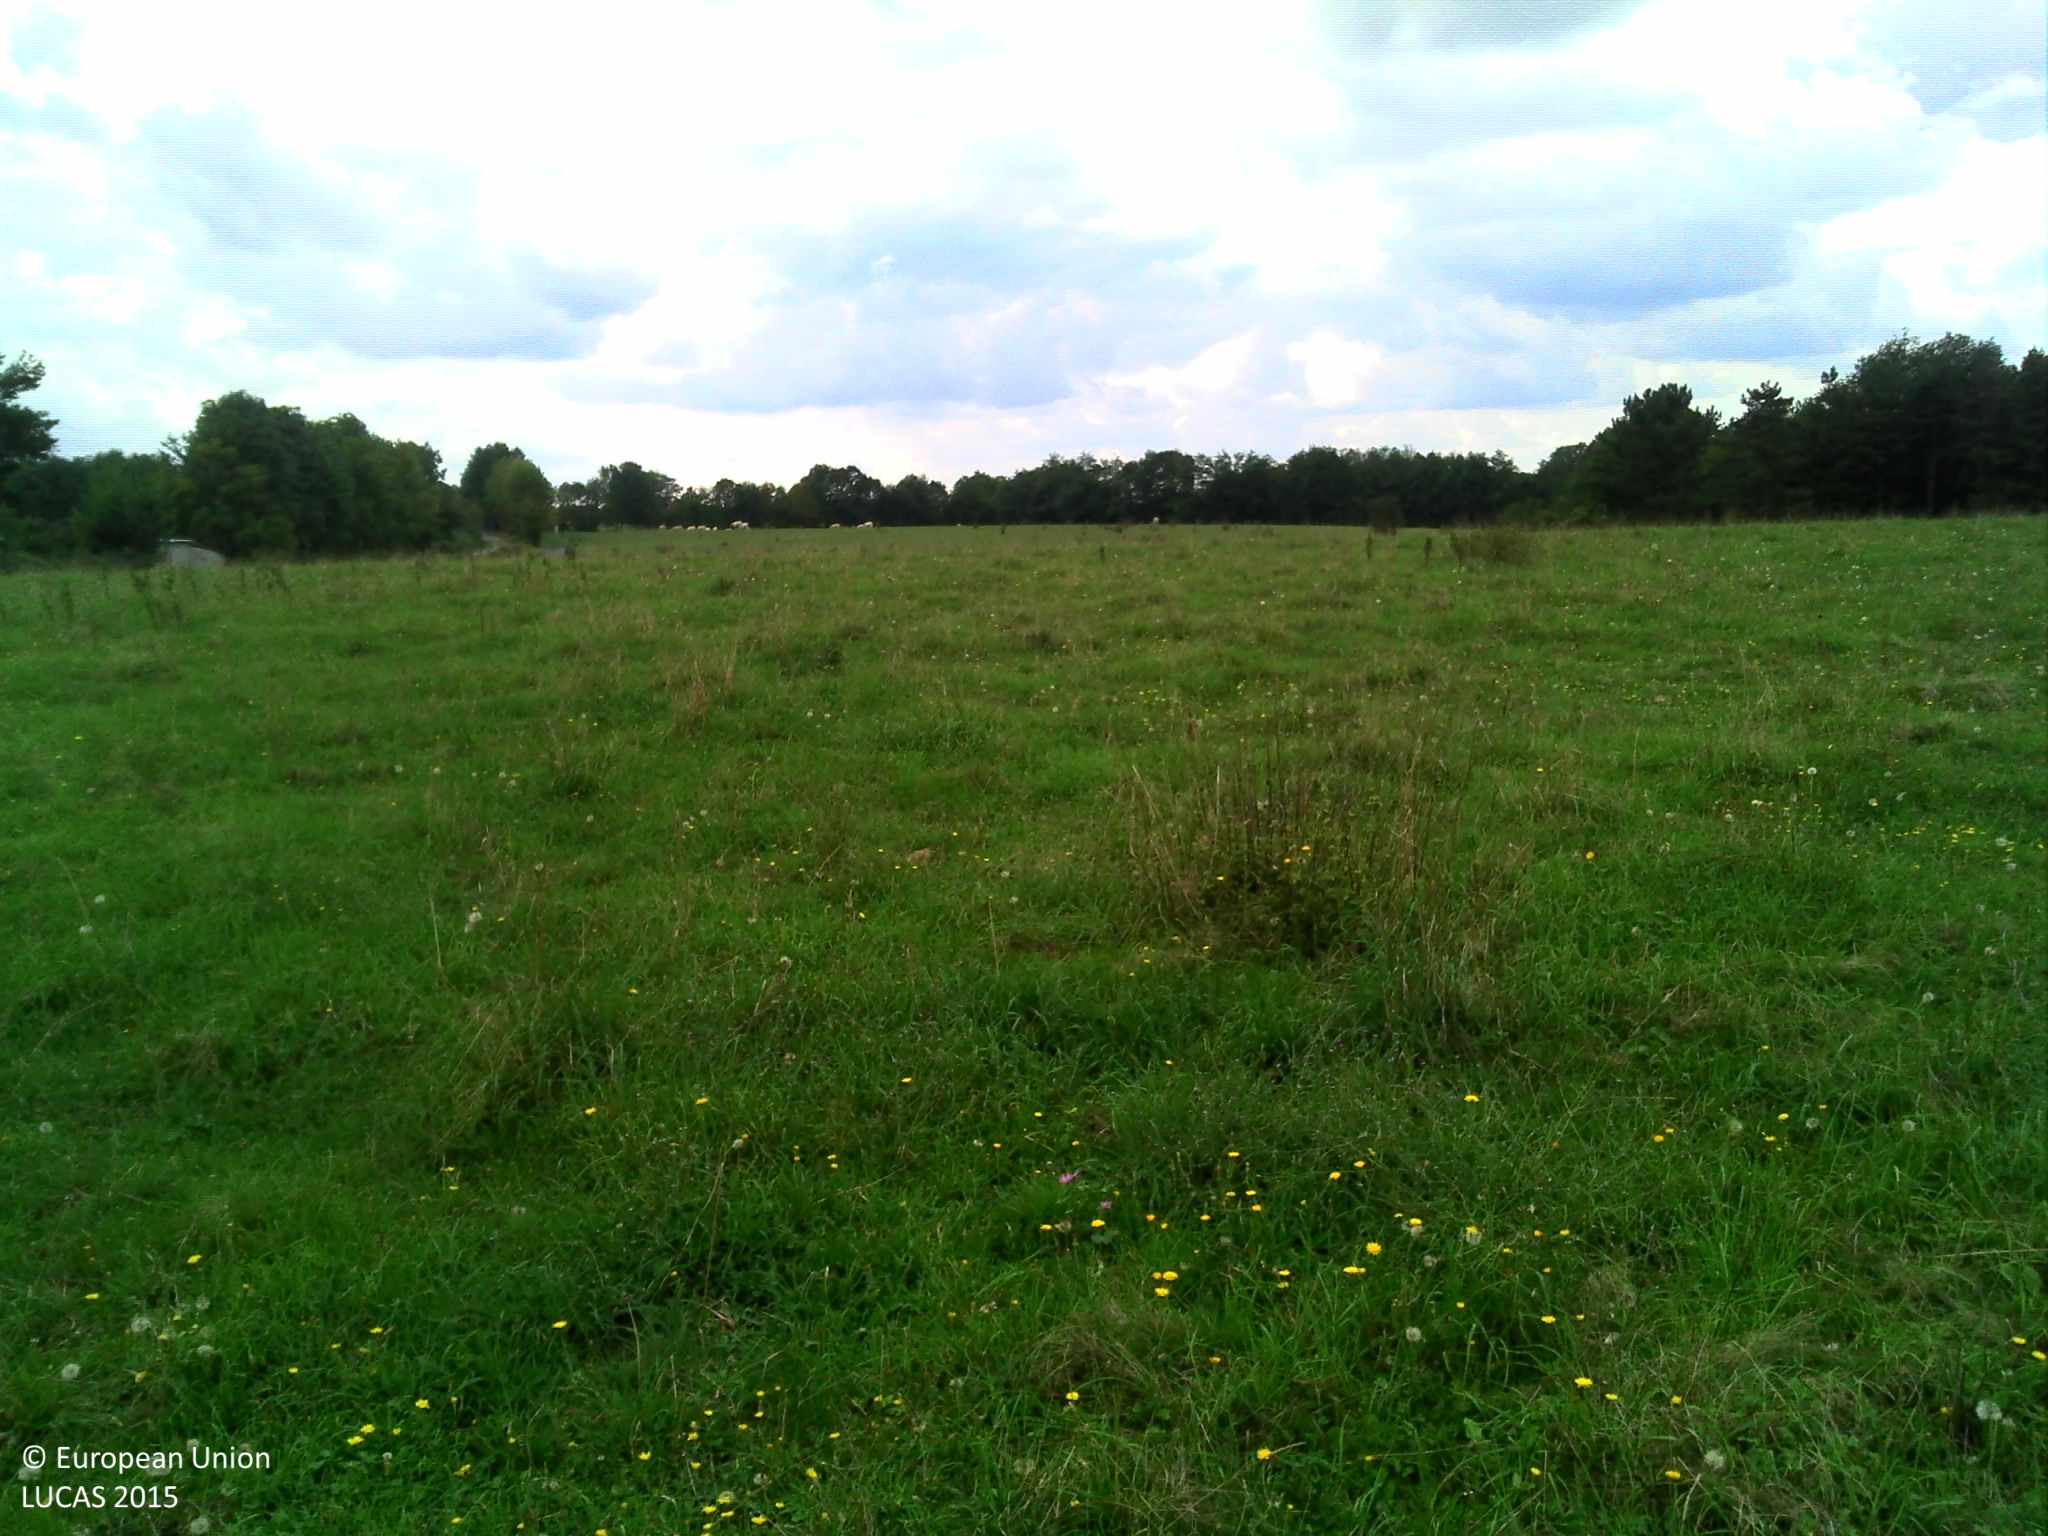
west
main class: Grassland
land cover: Grassland without tree/shrub cover
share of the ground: > 75 %
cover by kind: herbaceous plants 100 %
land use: Agriculture (excluding fallow land and kitchen gardens)
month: September
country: FR
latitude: 43.4136
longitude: -0.1700
